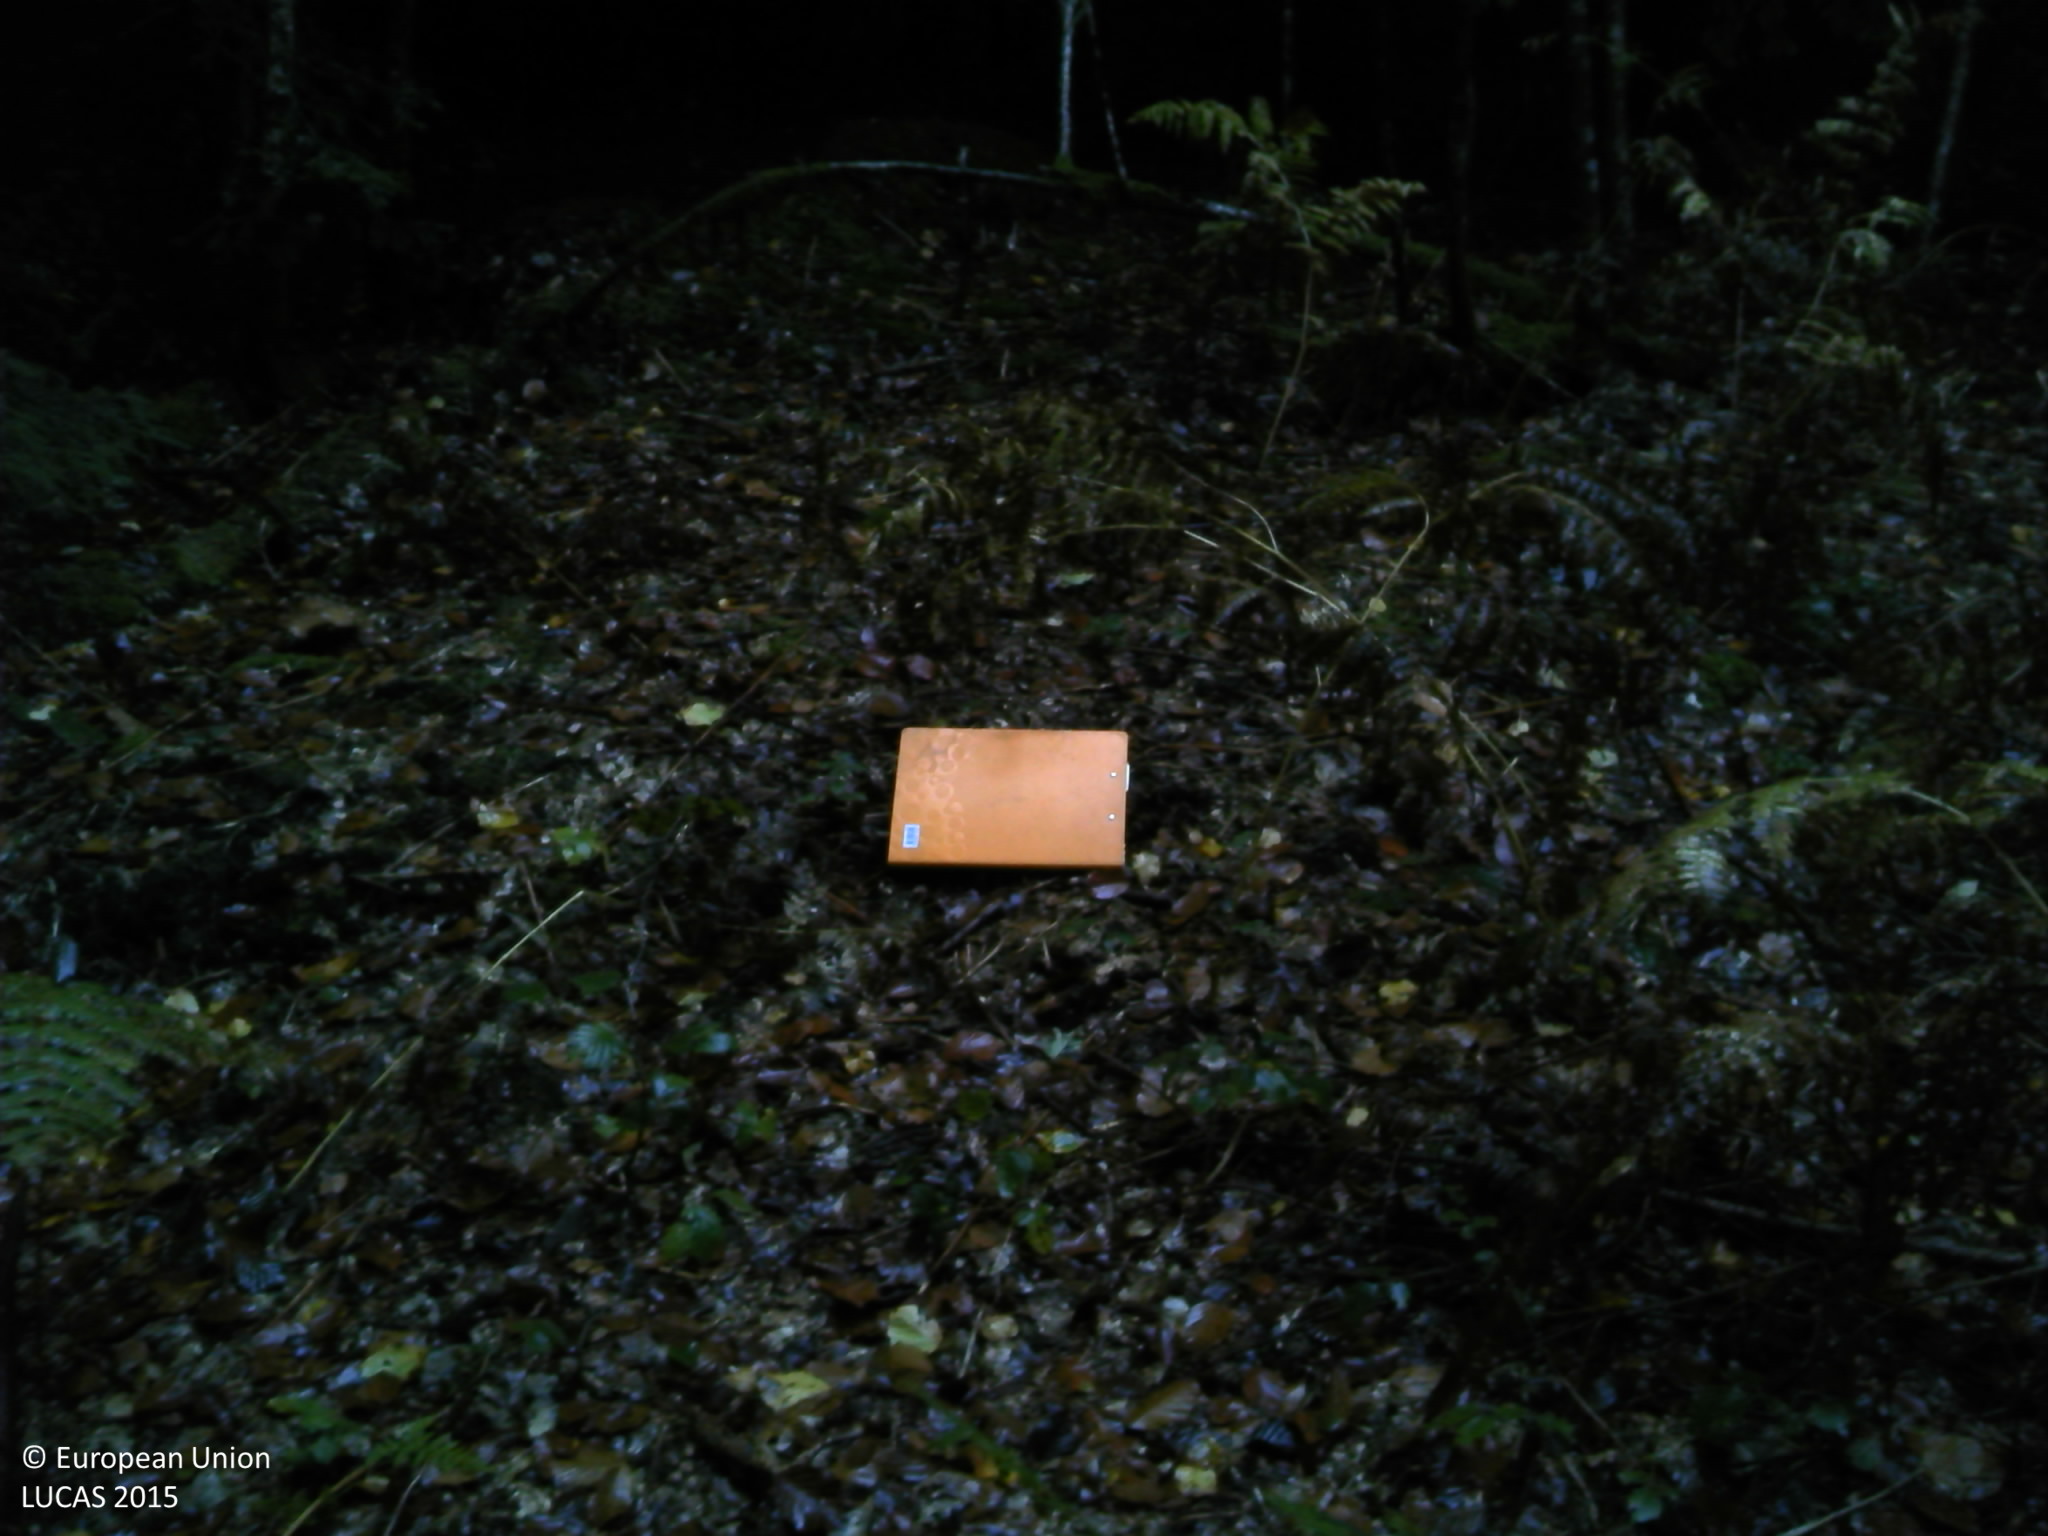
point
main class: Woodland
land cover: Spruce dominated coniferous woodland
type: alpine coniferous forest
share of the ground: > 75 %
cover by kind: coniferous forest trees 85 %, broadleaved forest trees 15 %
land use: Forestry
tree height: > 5 m
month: October
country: FR
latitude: 46.9782
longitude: 4.0177
